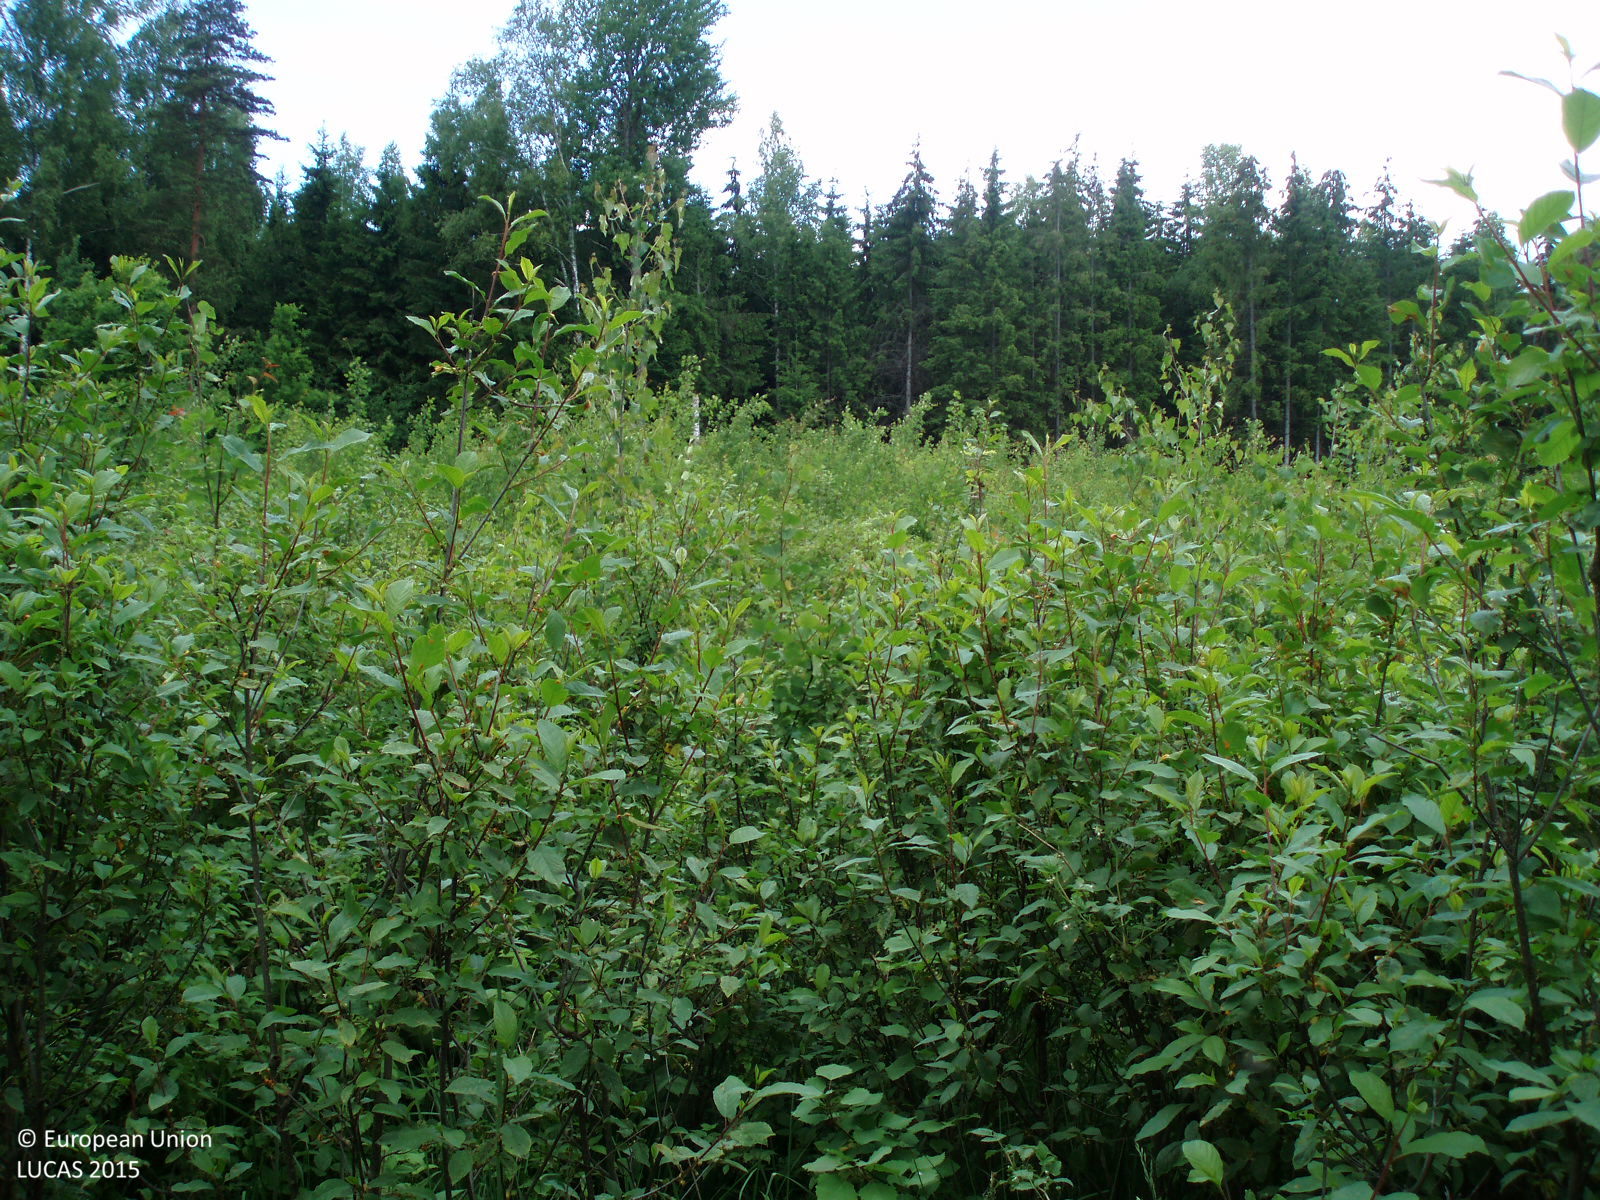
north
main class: Woodland
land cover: Broadleaved woodland
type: non-riverine alder, birch or aspen forest
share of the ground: 25 - 50 %
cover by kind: shrubs 50 %, broadleaved forest trees 30 %, herbaceous plants 20 %
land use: Forestry
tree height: < 5 m
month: June
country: LT
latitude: 55.0801
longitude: 22.5157
